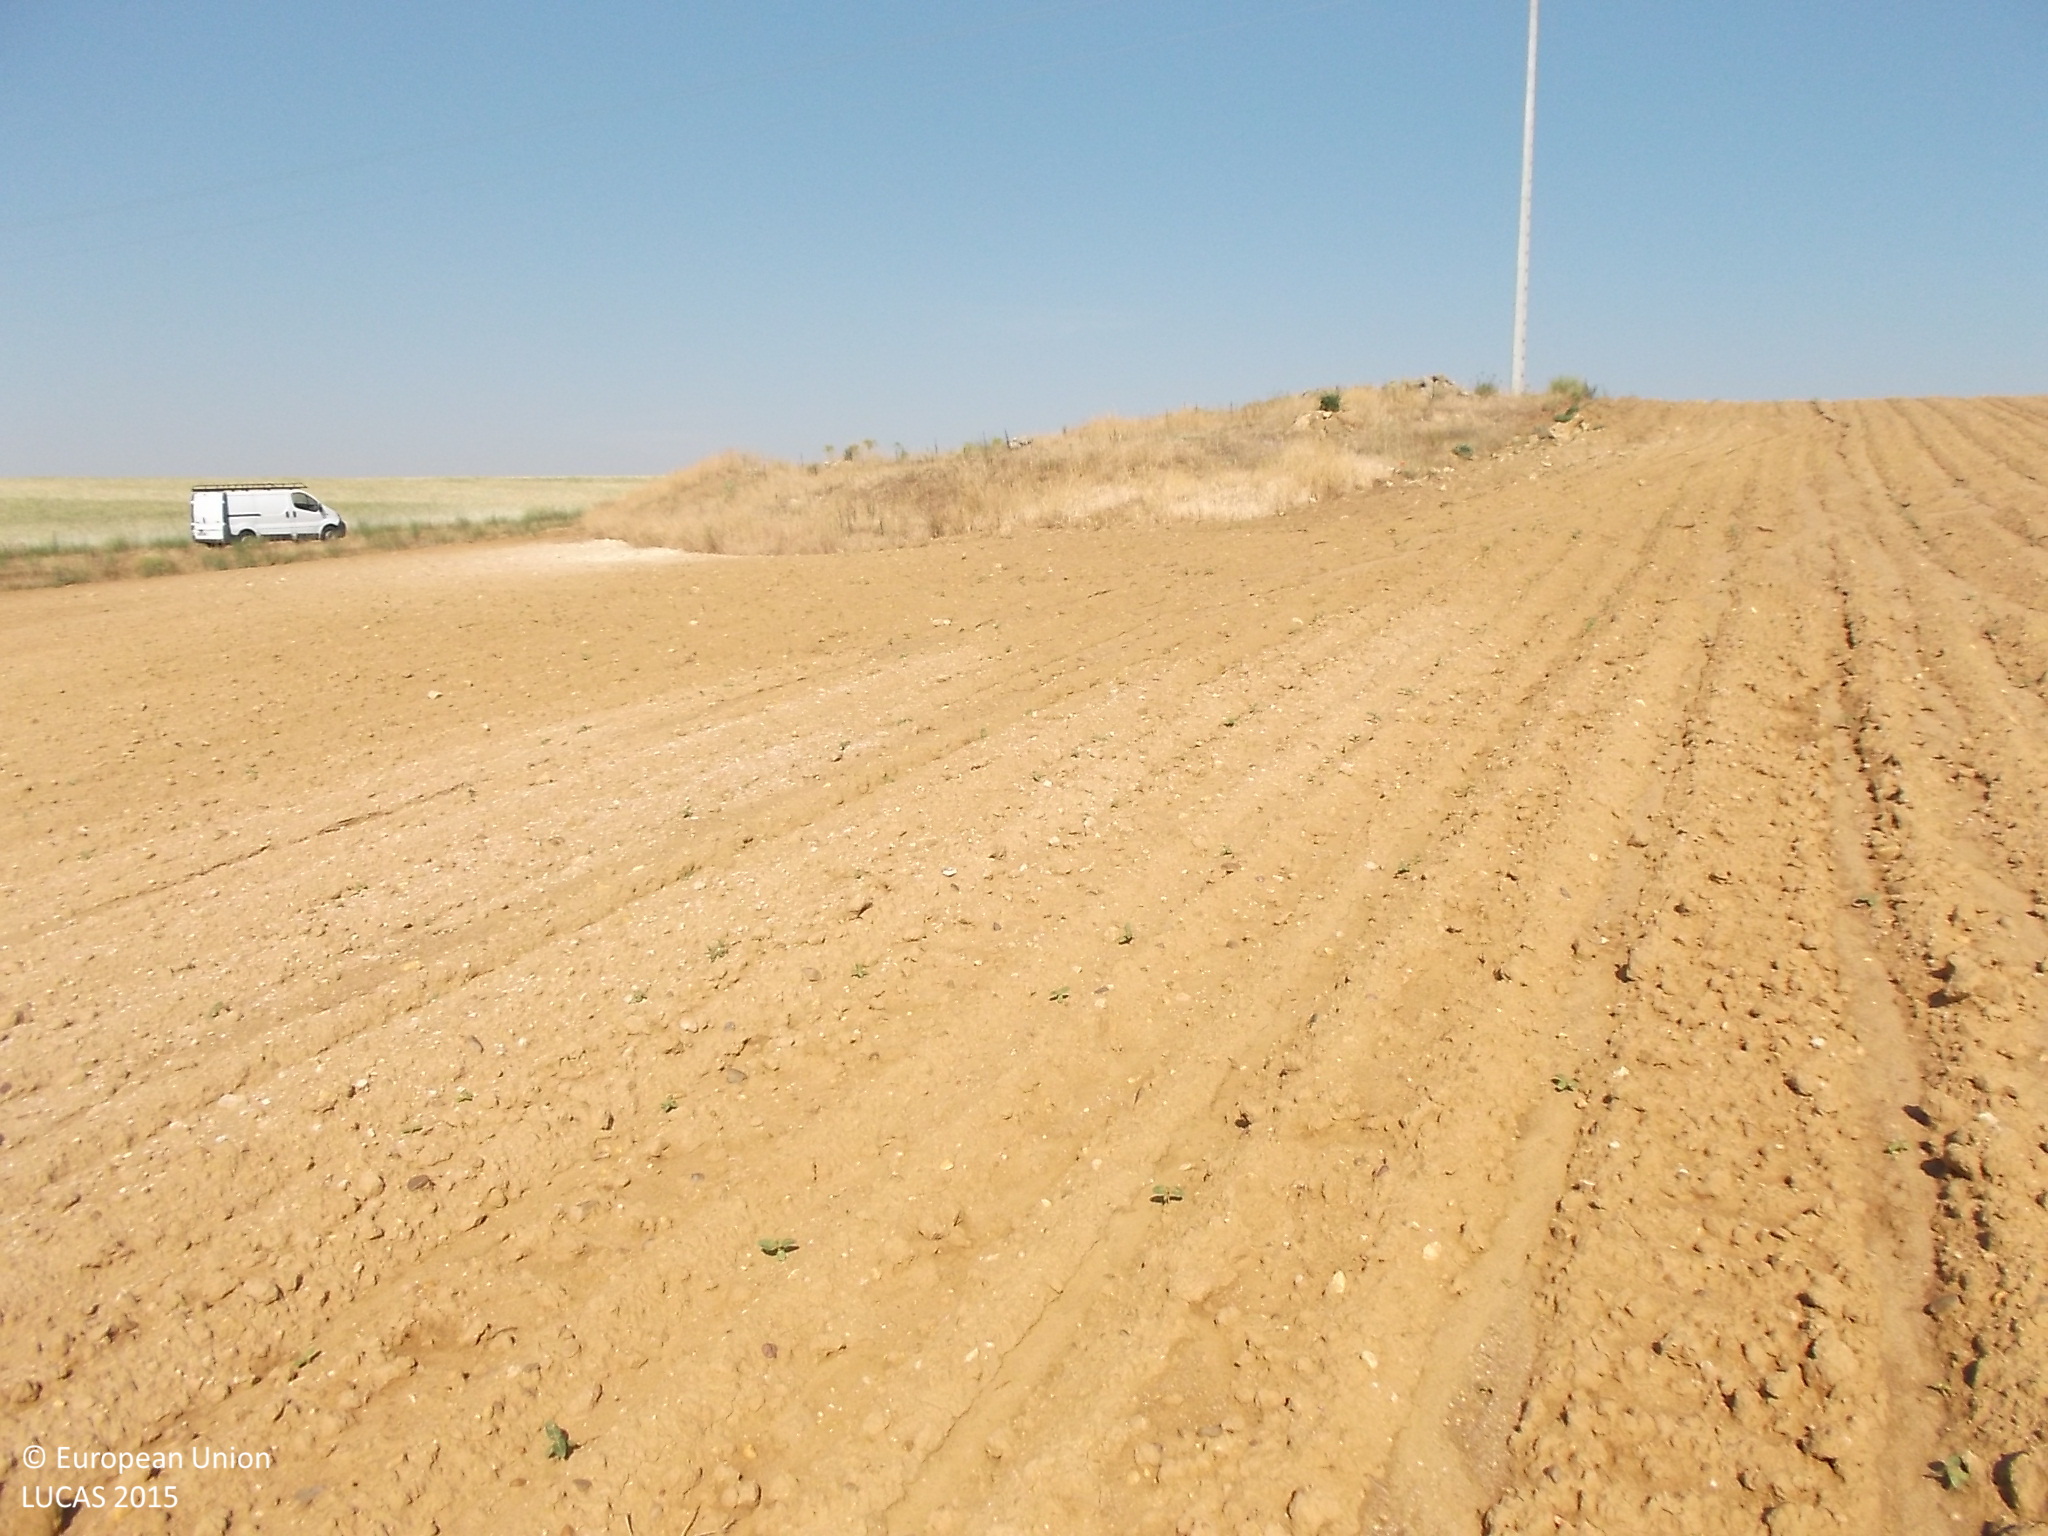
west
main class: Cropland
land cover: Sunflower
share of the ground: < 10 %
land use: Agriculture (excluding fallow land and kitchen gardens)
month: June
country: ES
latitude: 41.3168
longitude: -5.4280
